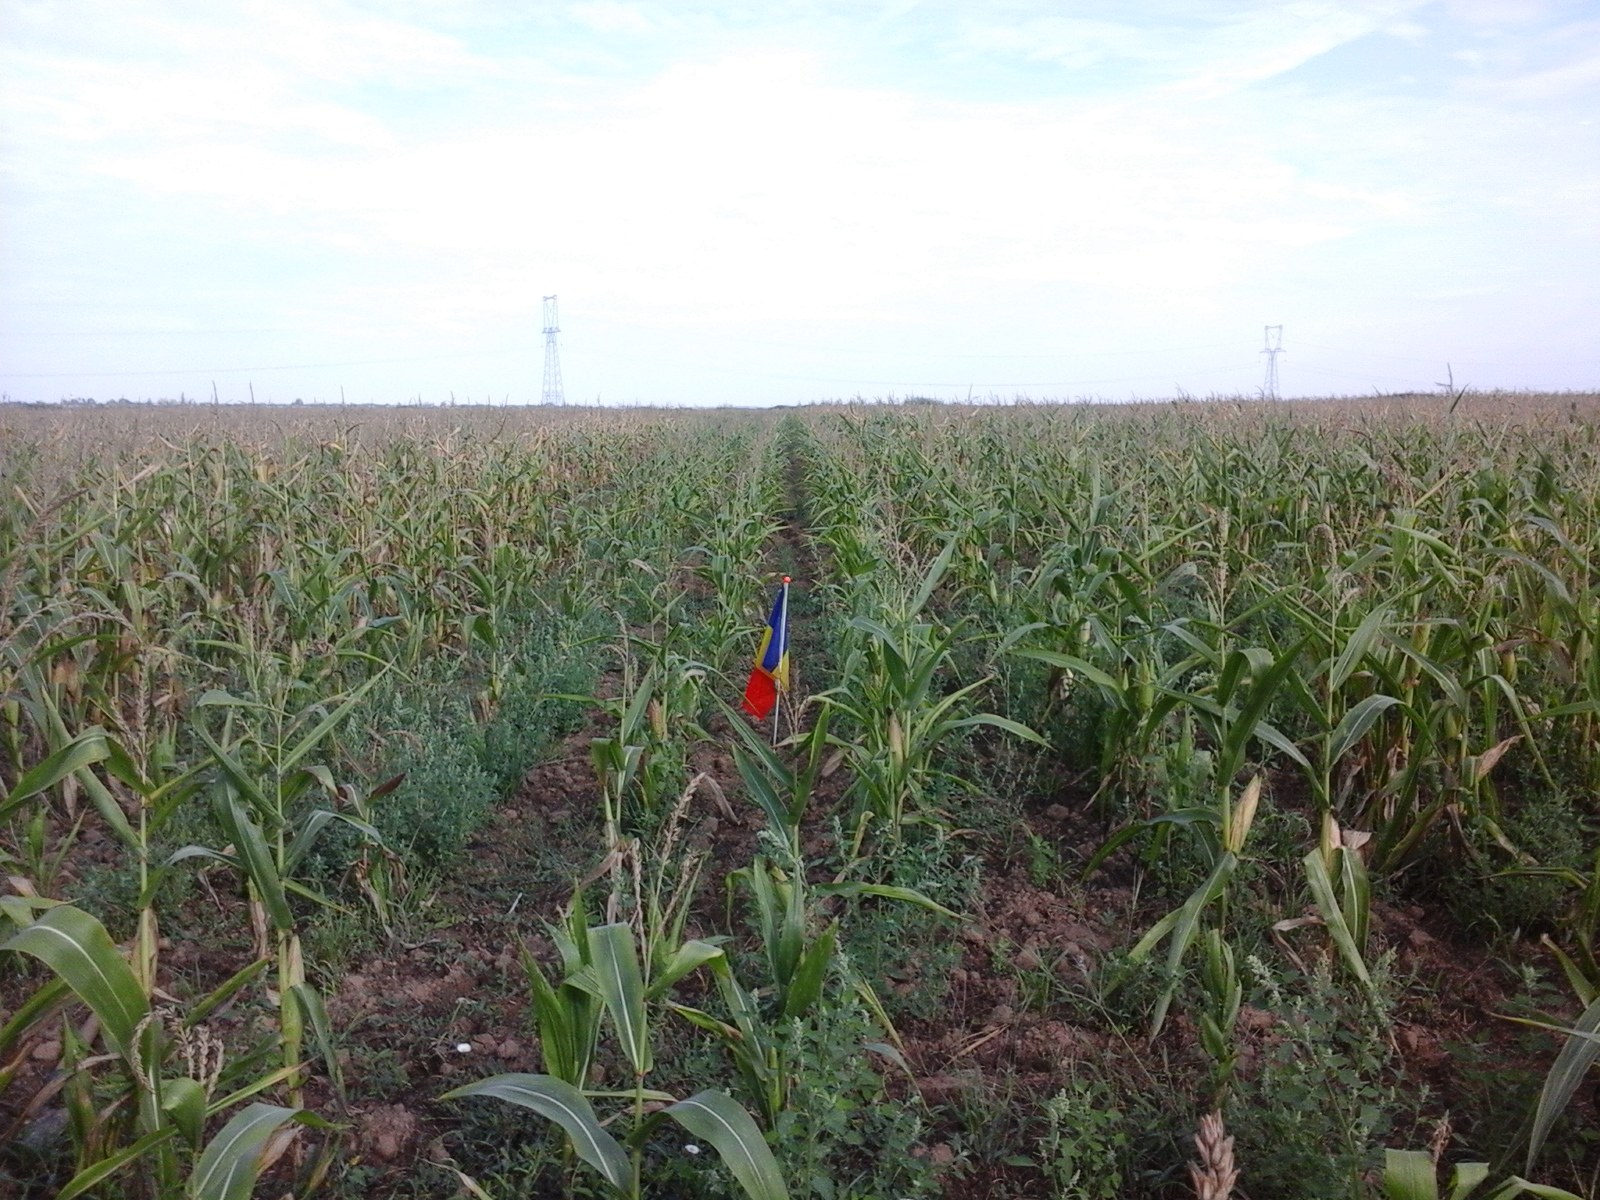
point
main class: Cropland
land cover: Maize
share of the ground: > 75 %
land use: Agriculture (excluding fallow land and kitchen gardens)
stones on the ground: < 10 %
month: August
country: RO
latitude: 46.4702
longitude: 21.5375
